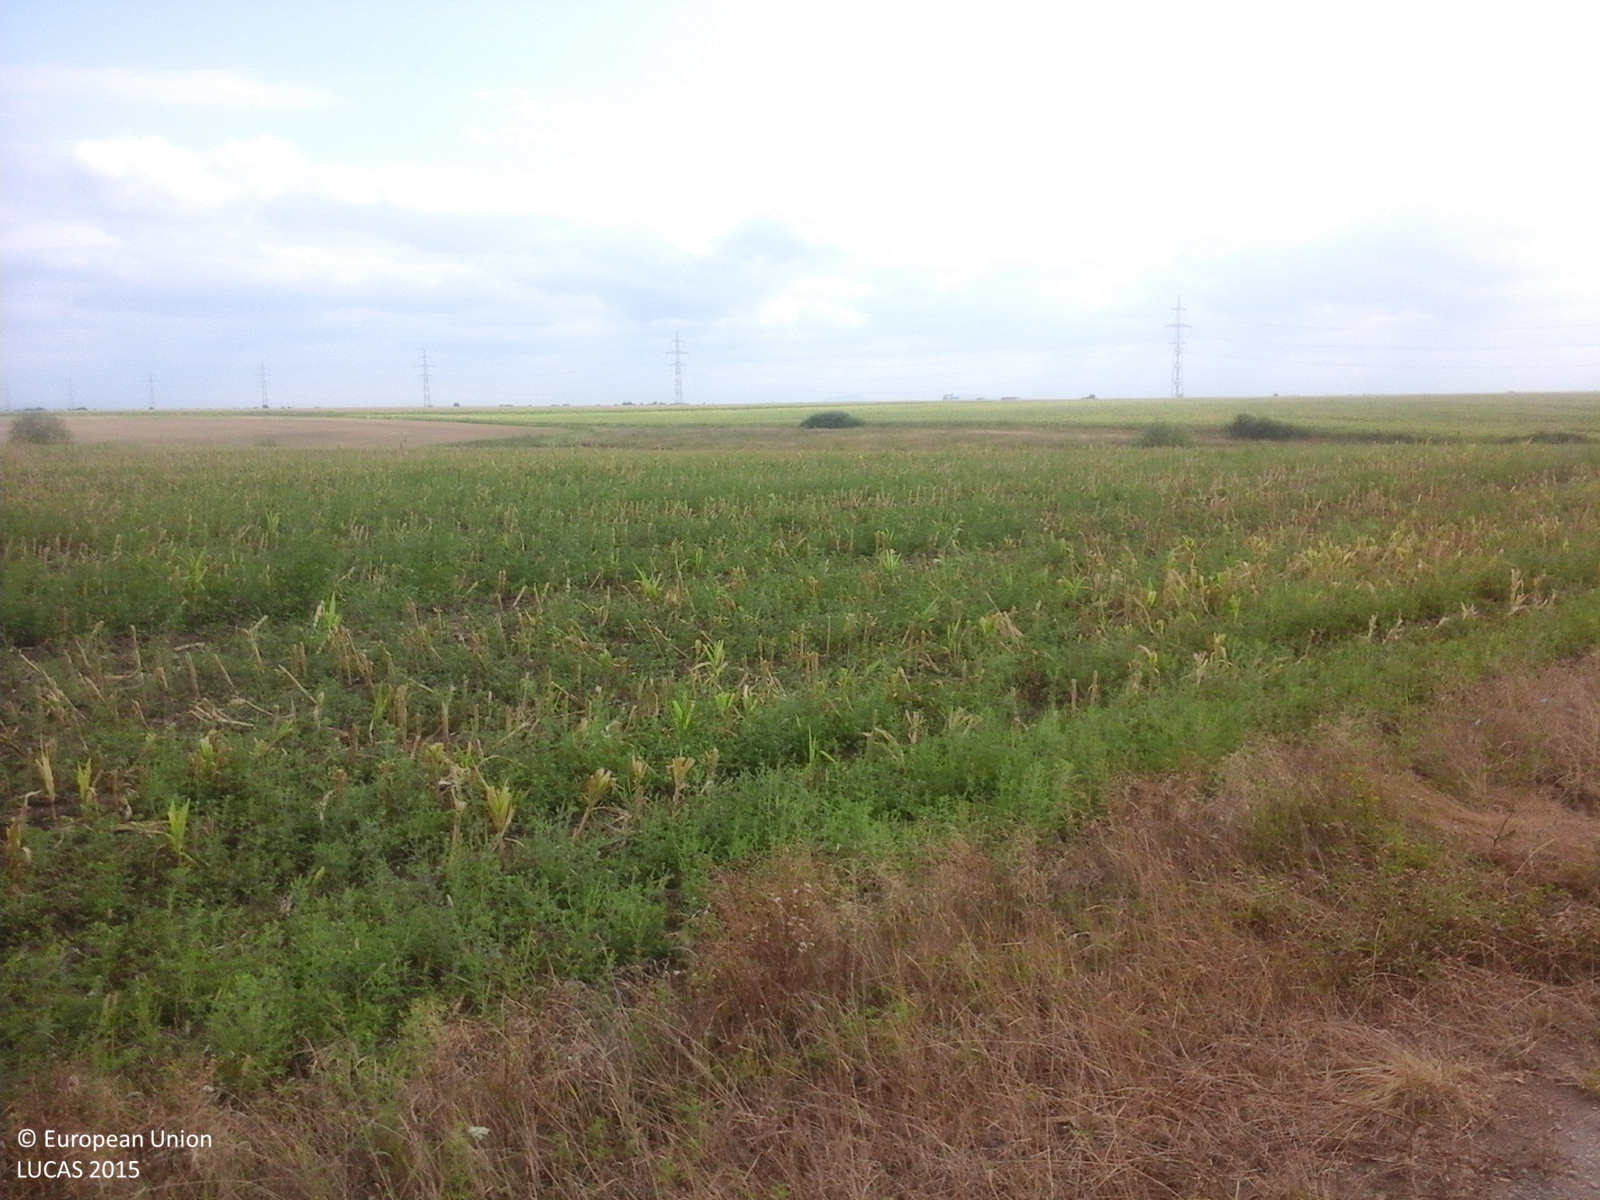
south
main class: Cropland
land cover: Sunflower
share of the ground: > 75 %
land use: Agriculture (excluding fallow land and kitchen gardens)
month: August
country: RO
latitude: 45.5528
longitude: 21.4453
